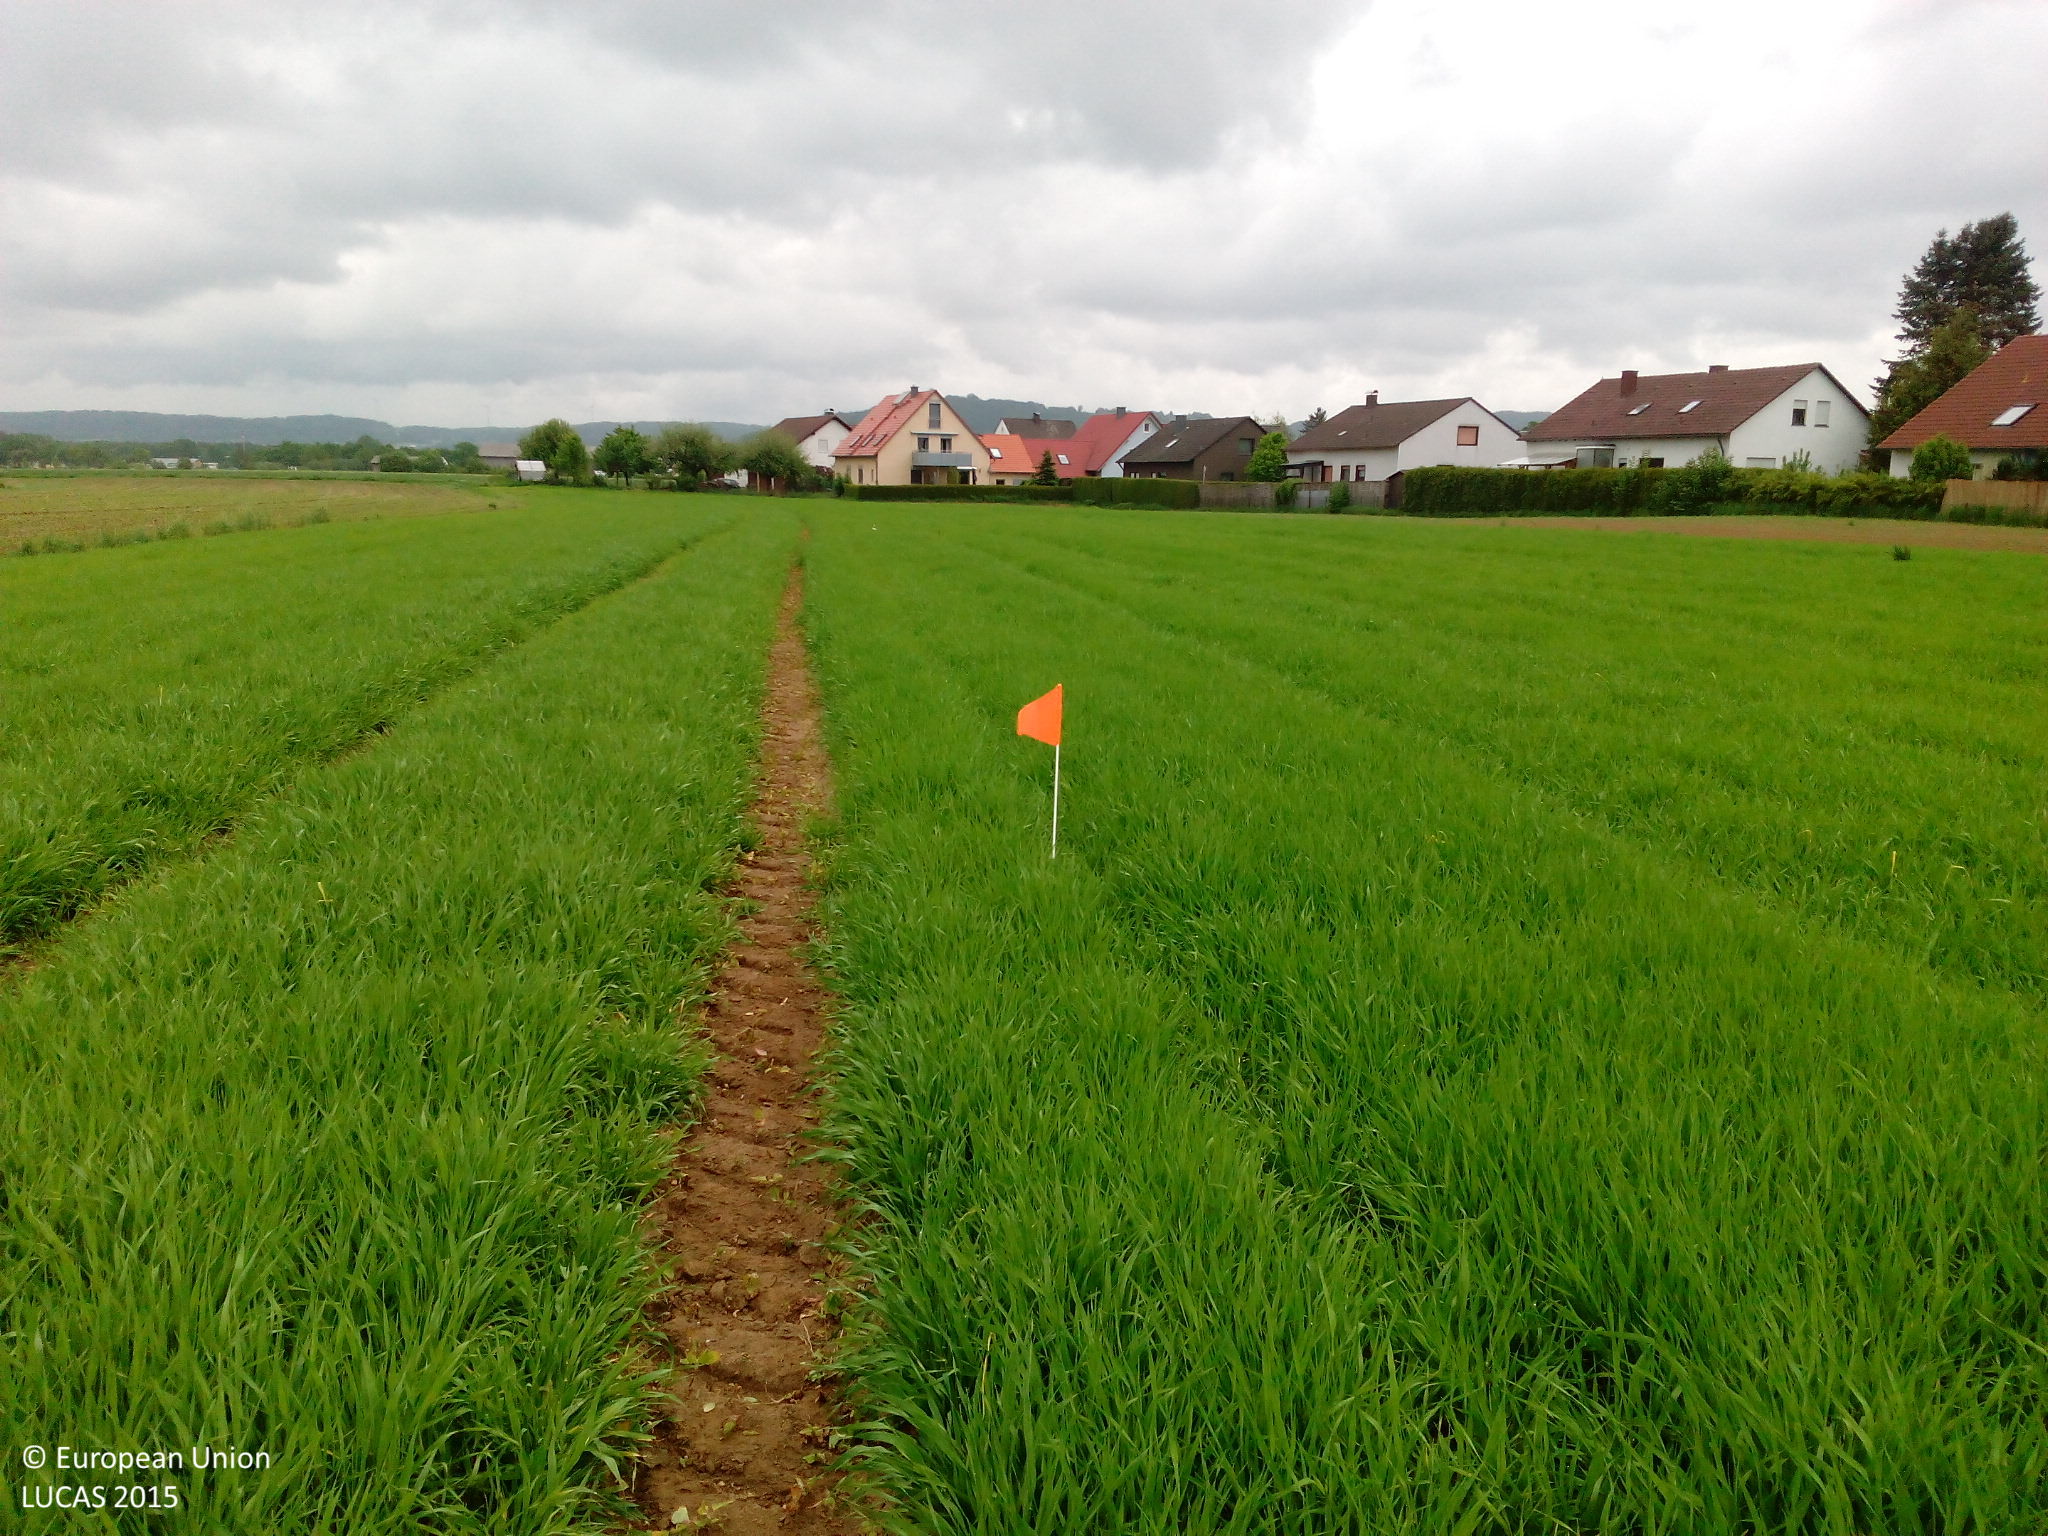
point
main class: Cropland
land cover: Barley
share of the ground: > 75 %
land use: Agriculture (excluding fallow land and kitchen gardens)
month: May
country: DE
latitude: 49.2937
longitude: 11.4433
